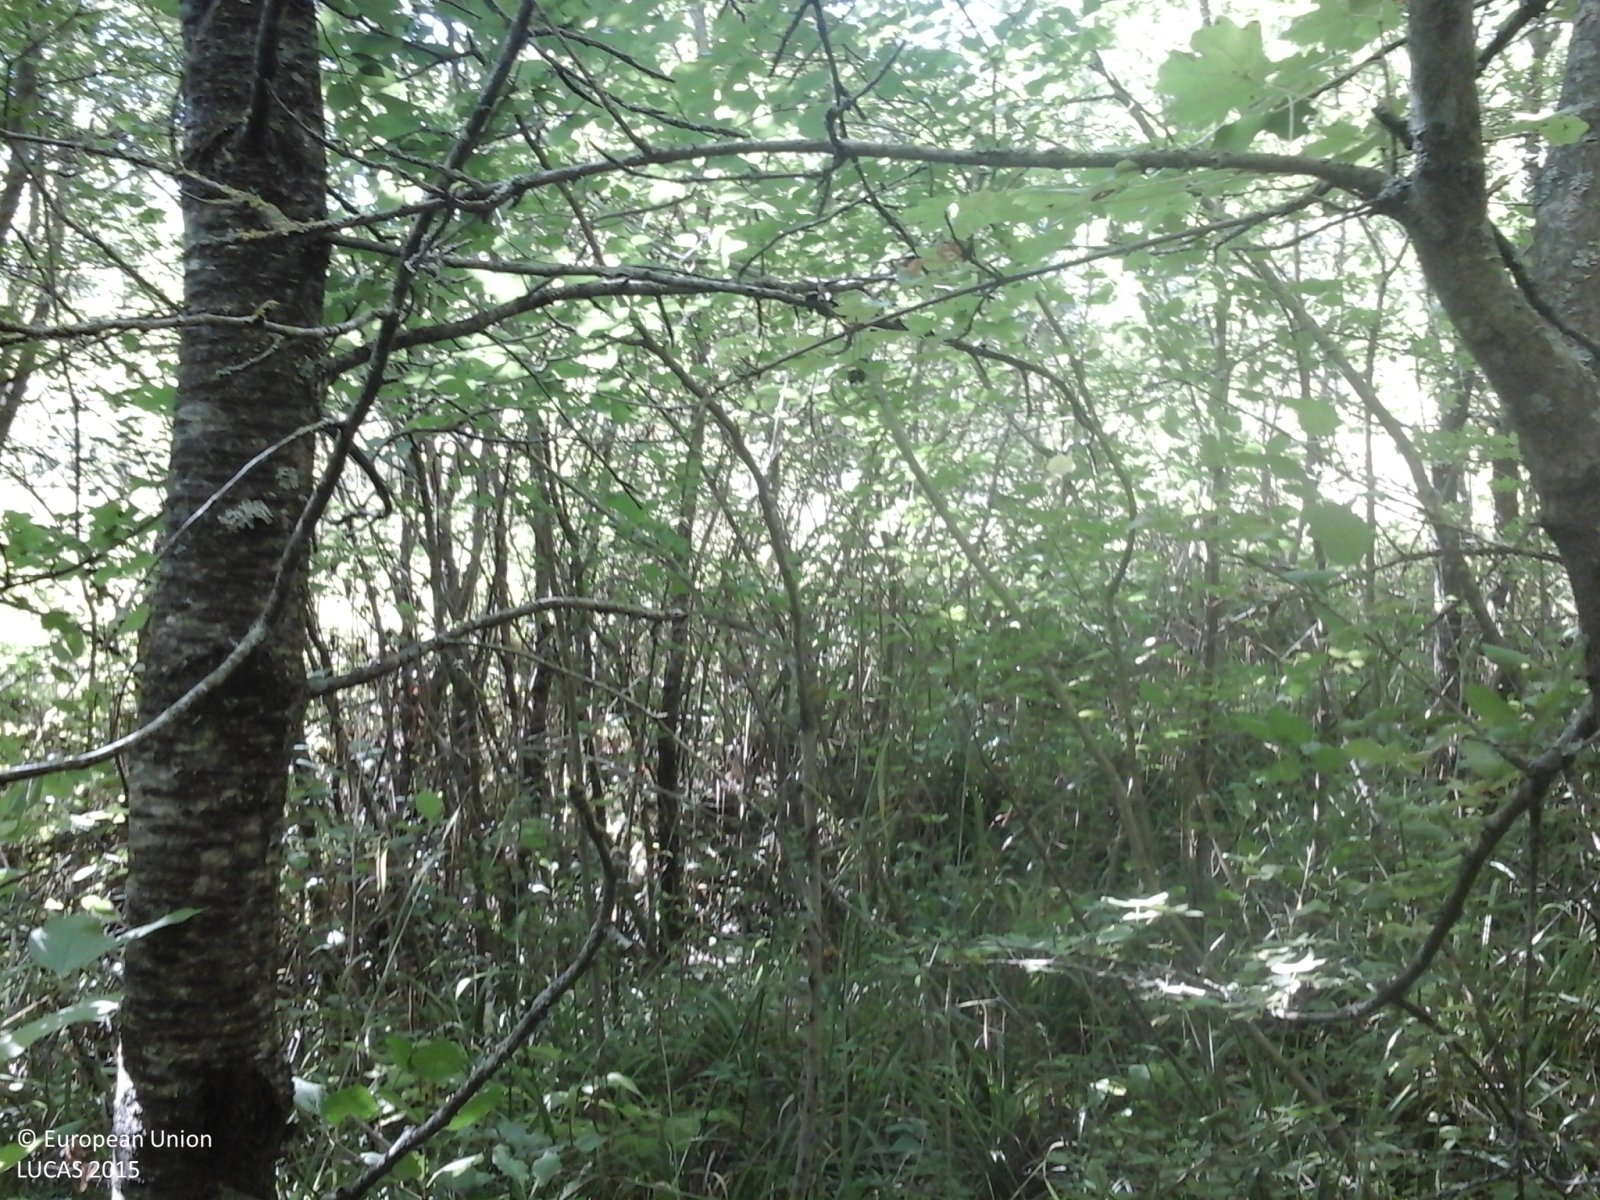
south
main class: Woodland
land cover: Broadleaved woodland
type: thermophilous deciduous forest
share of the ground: > 75 %
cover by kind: broadleaved forest trees 95 %, shrubs 5 %
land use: Forestry
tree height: > 5 m
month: August
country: IT
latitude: 43.1064
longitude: 13.2965
